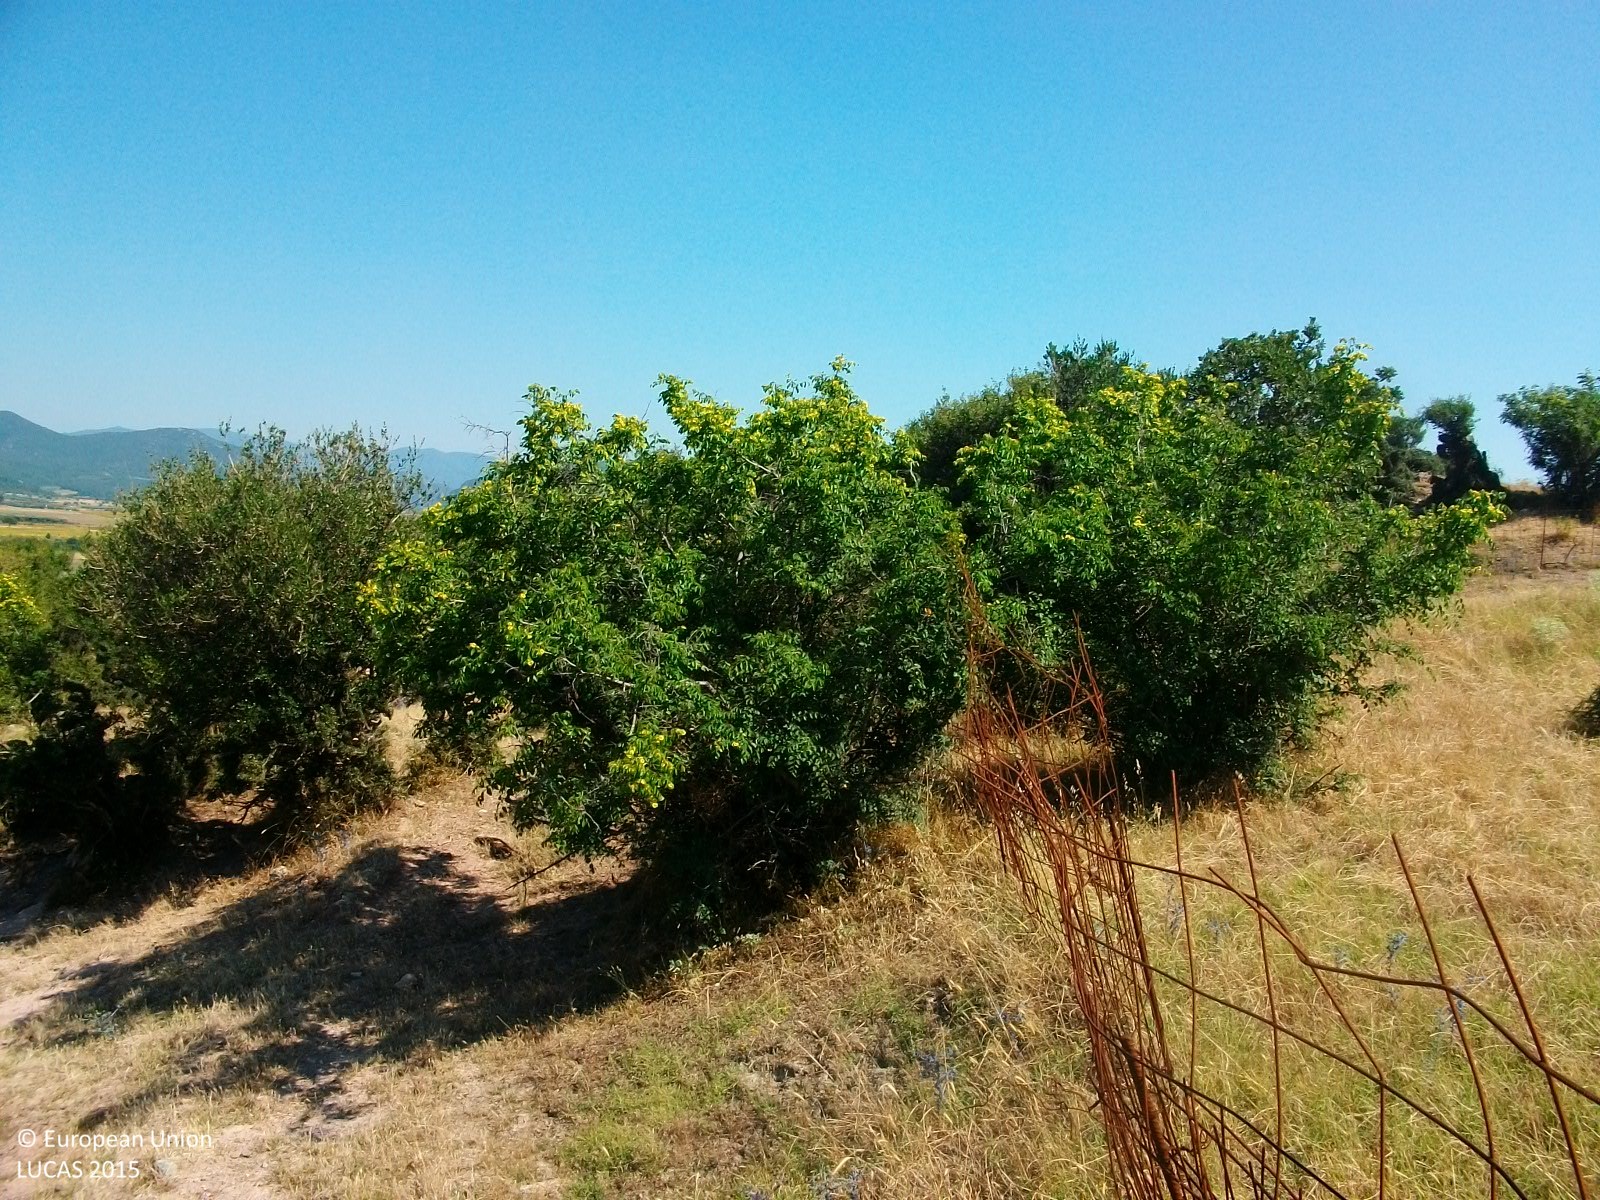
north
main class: Grassland
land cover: Spontaneously vegetated surfaces
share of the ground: > 75 %
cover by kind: herbaceous plants 95 %, shrubs 5 %
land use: Agriculture (excluding fallow land and kitchen gardens)
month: July
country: GR
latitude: 40.8883
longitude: 25.9258
